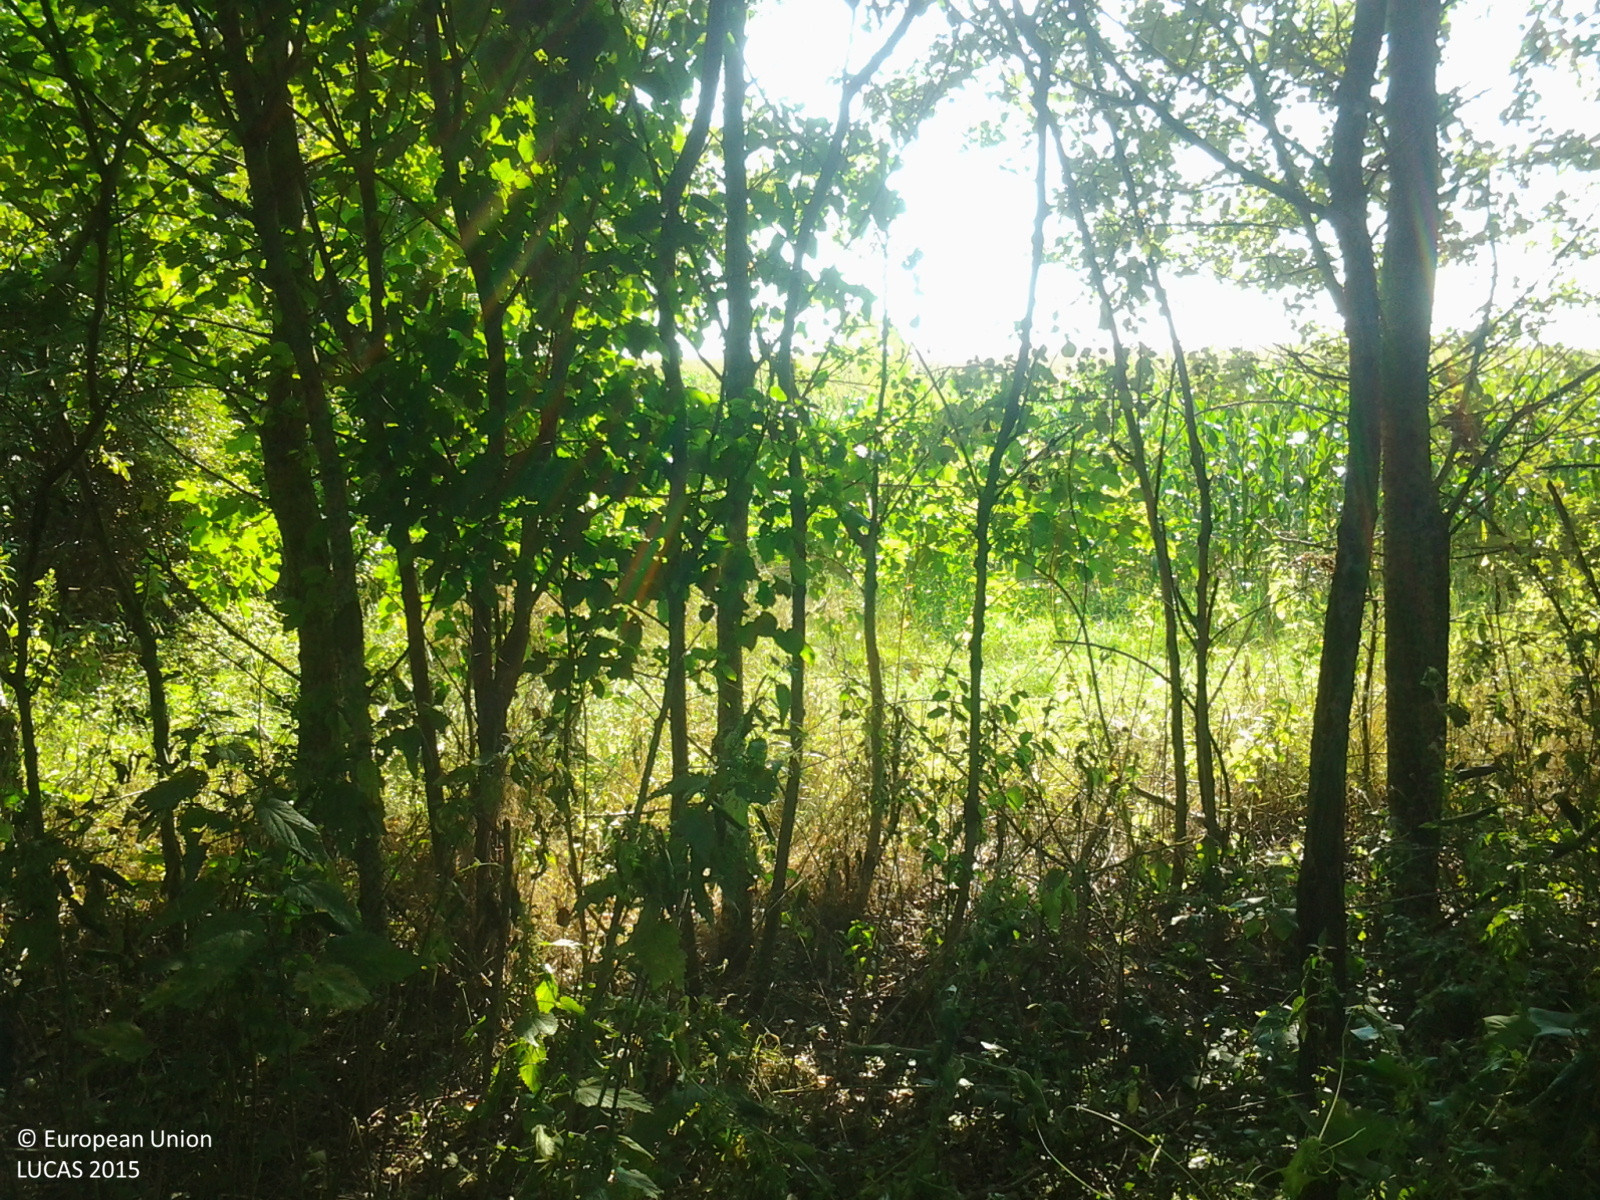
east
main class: Woodland
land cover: Broadleaved woodland
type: floodplain forest
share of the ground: > 75 %
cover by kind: broadleaved forest trees 95 %, herbaceous plants 5 %
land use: Forestry
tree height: > 5 m
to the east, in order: Broadleaved woodland; Tracks; Maize
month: August
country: HU
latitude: 46.4386
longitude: 18.1427
